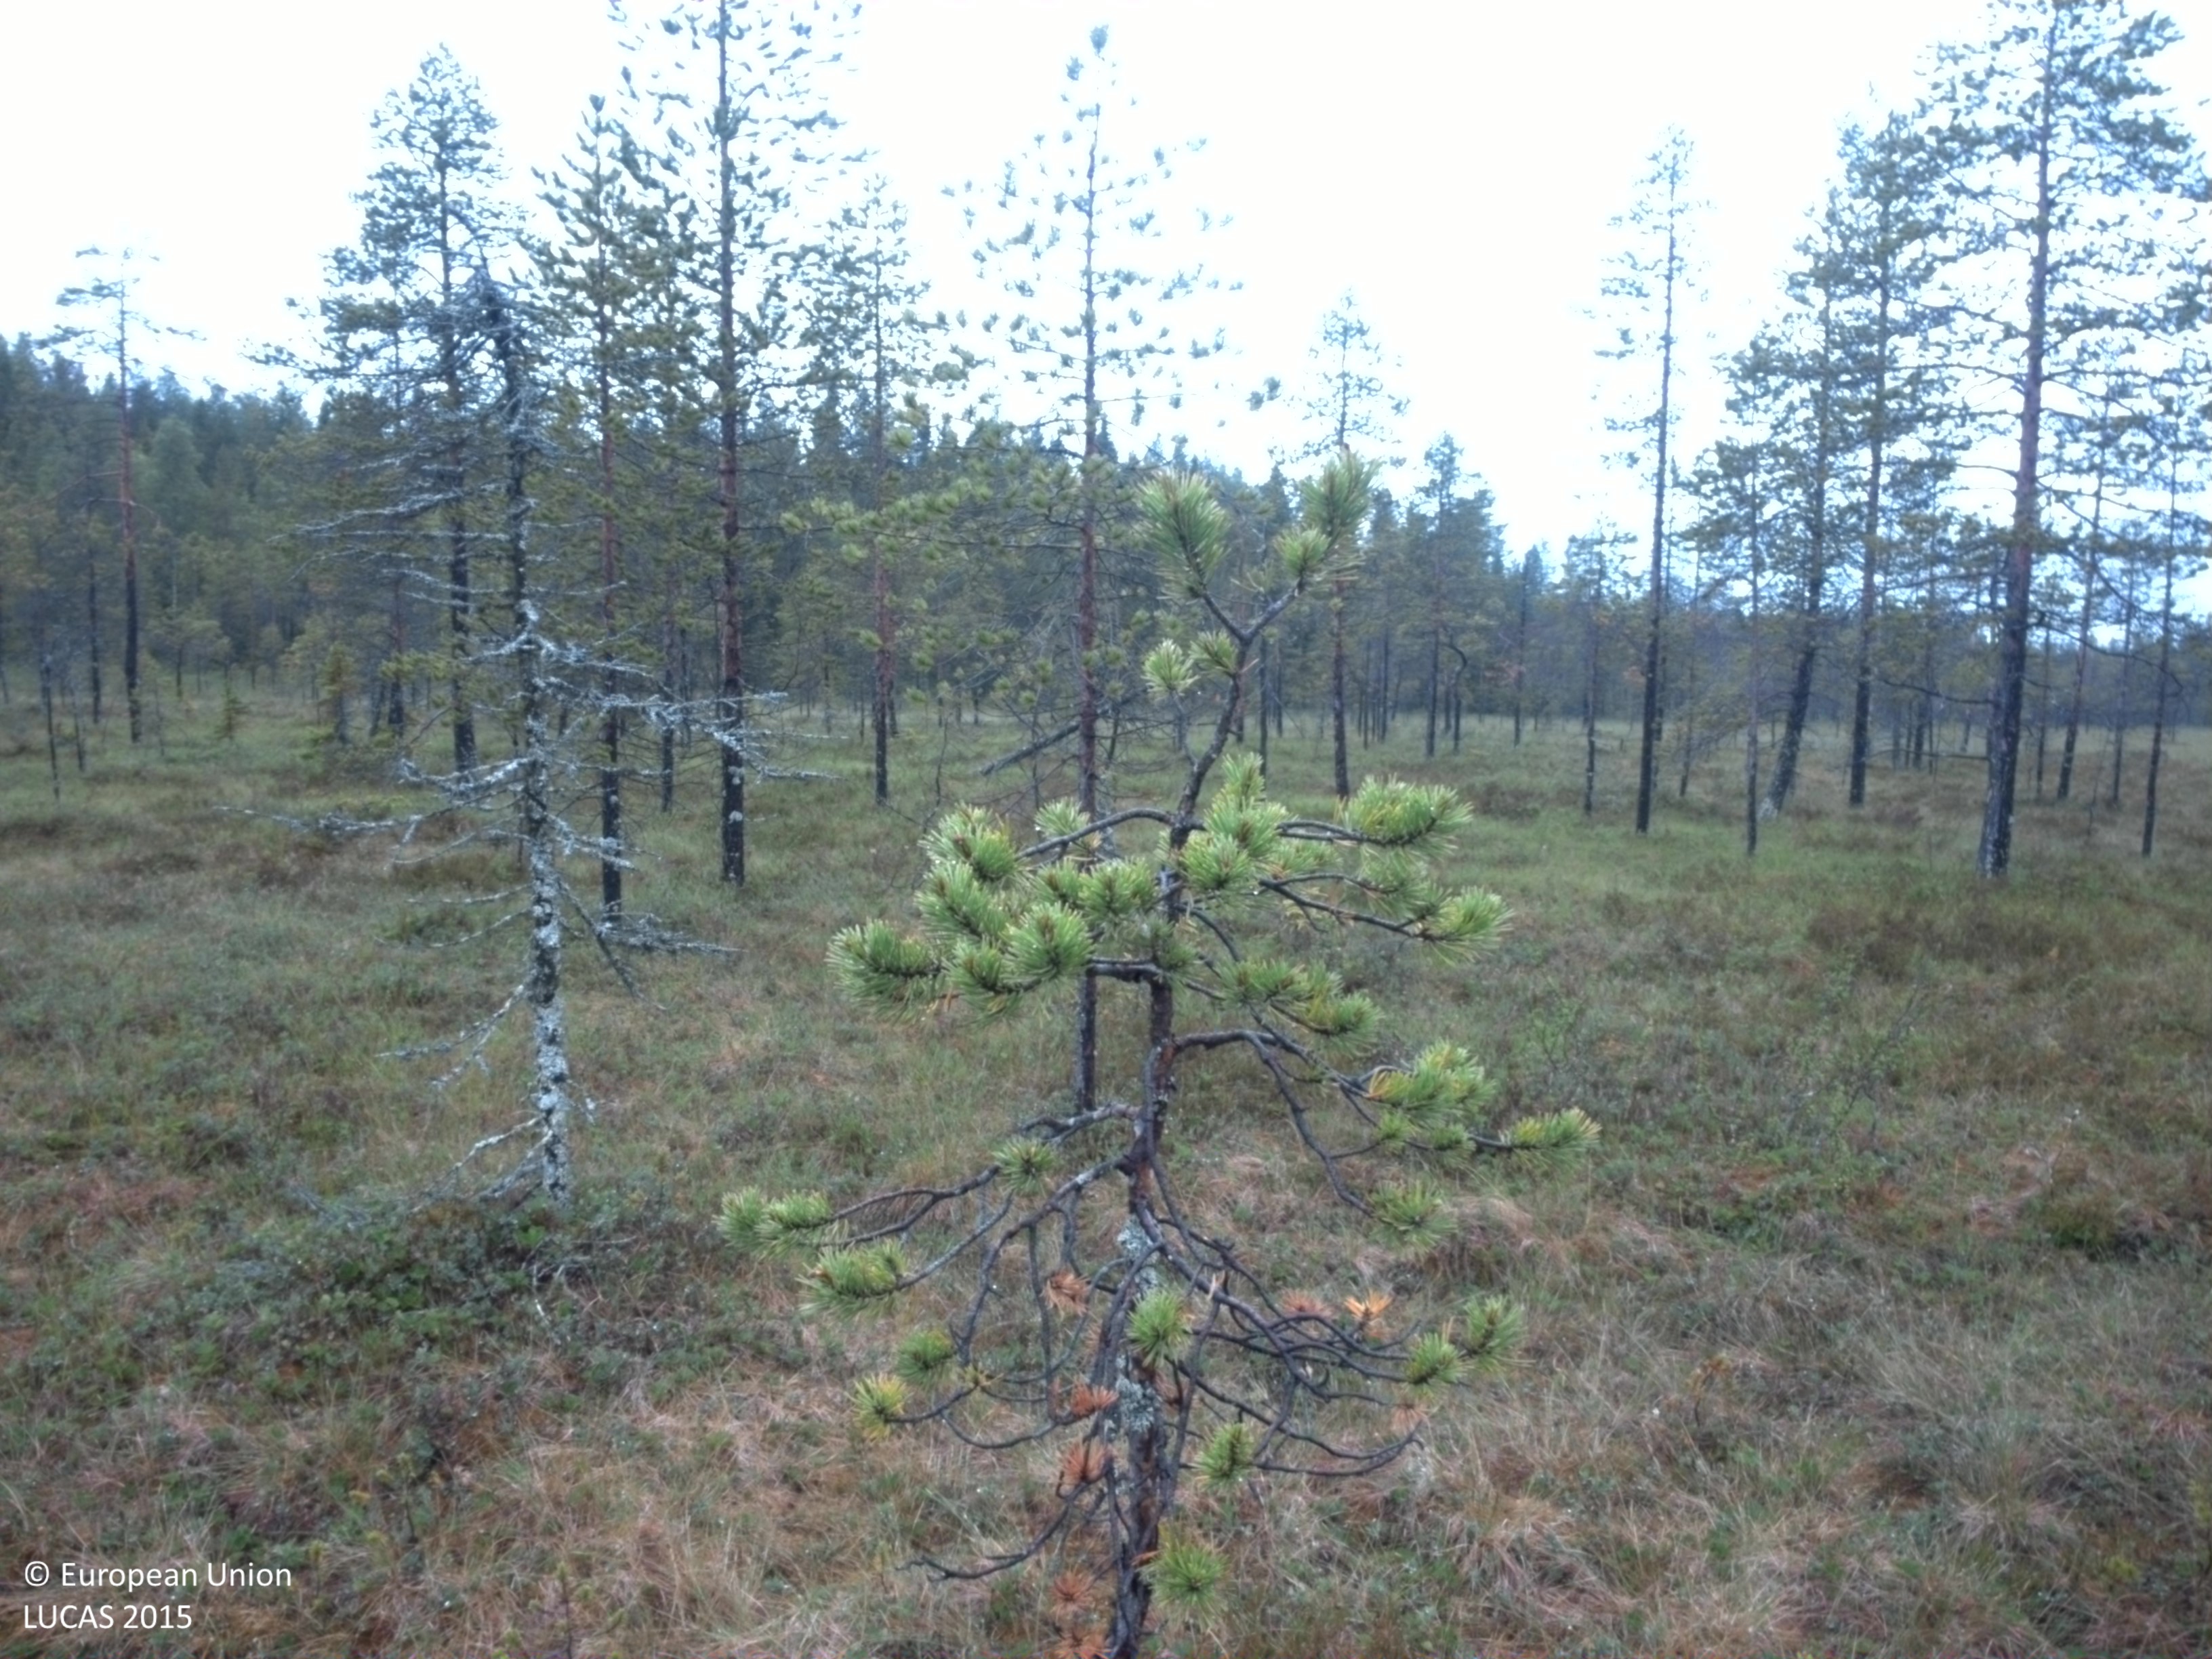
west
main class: Woodland
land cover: Pine dominated coniferous woodland
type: mire and swamp forests
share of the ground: 25 - 50 %
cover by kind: coniferous forest trees 40 %, herbaceous plants 30 %, shrubs 25 %, lichens and mosses 5 %
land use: Forestry
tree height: > 5 m
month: July
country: SE
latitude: 64.6050
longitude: 18.1801
